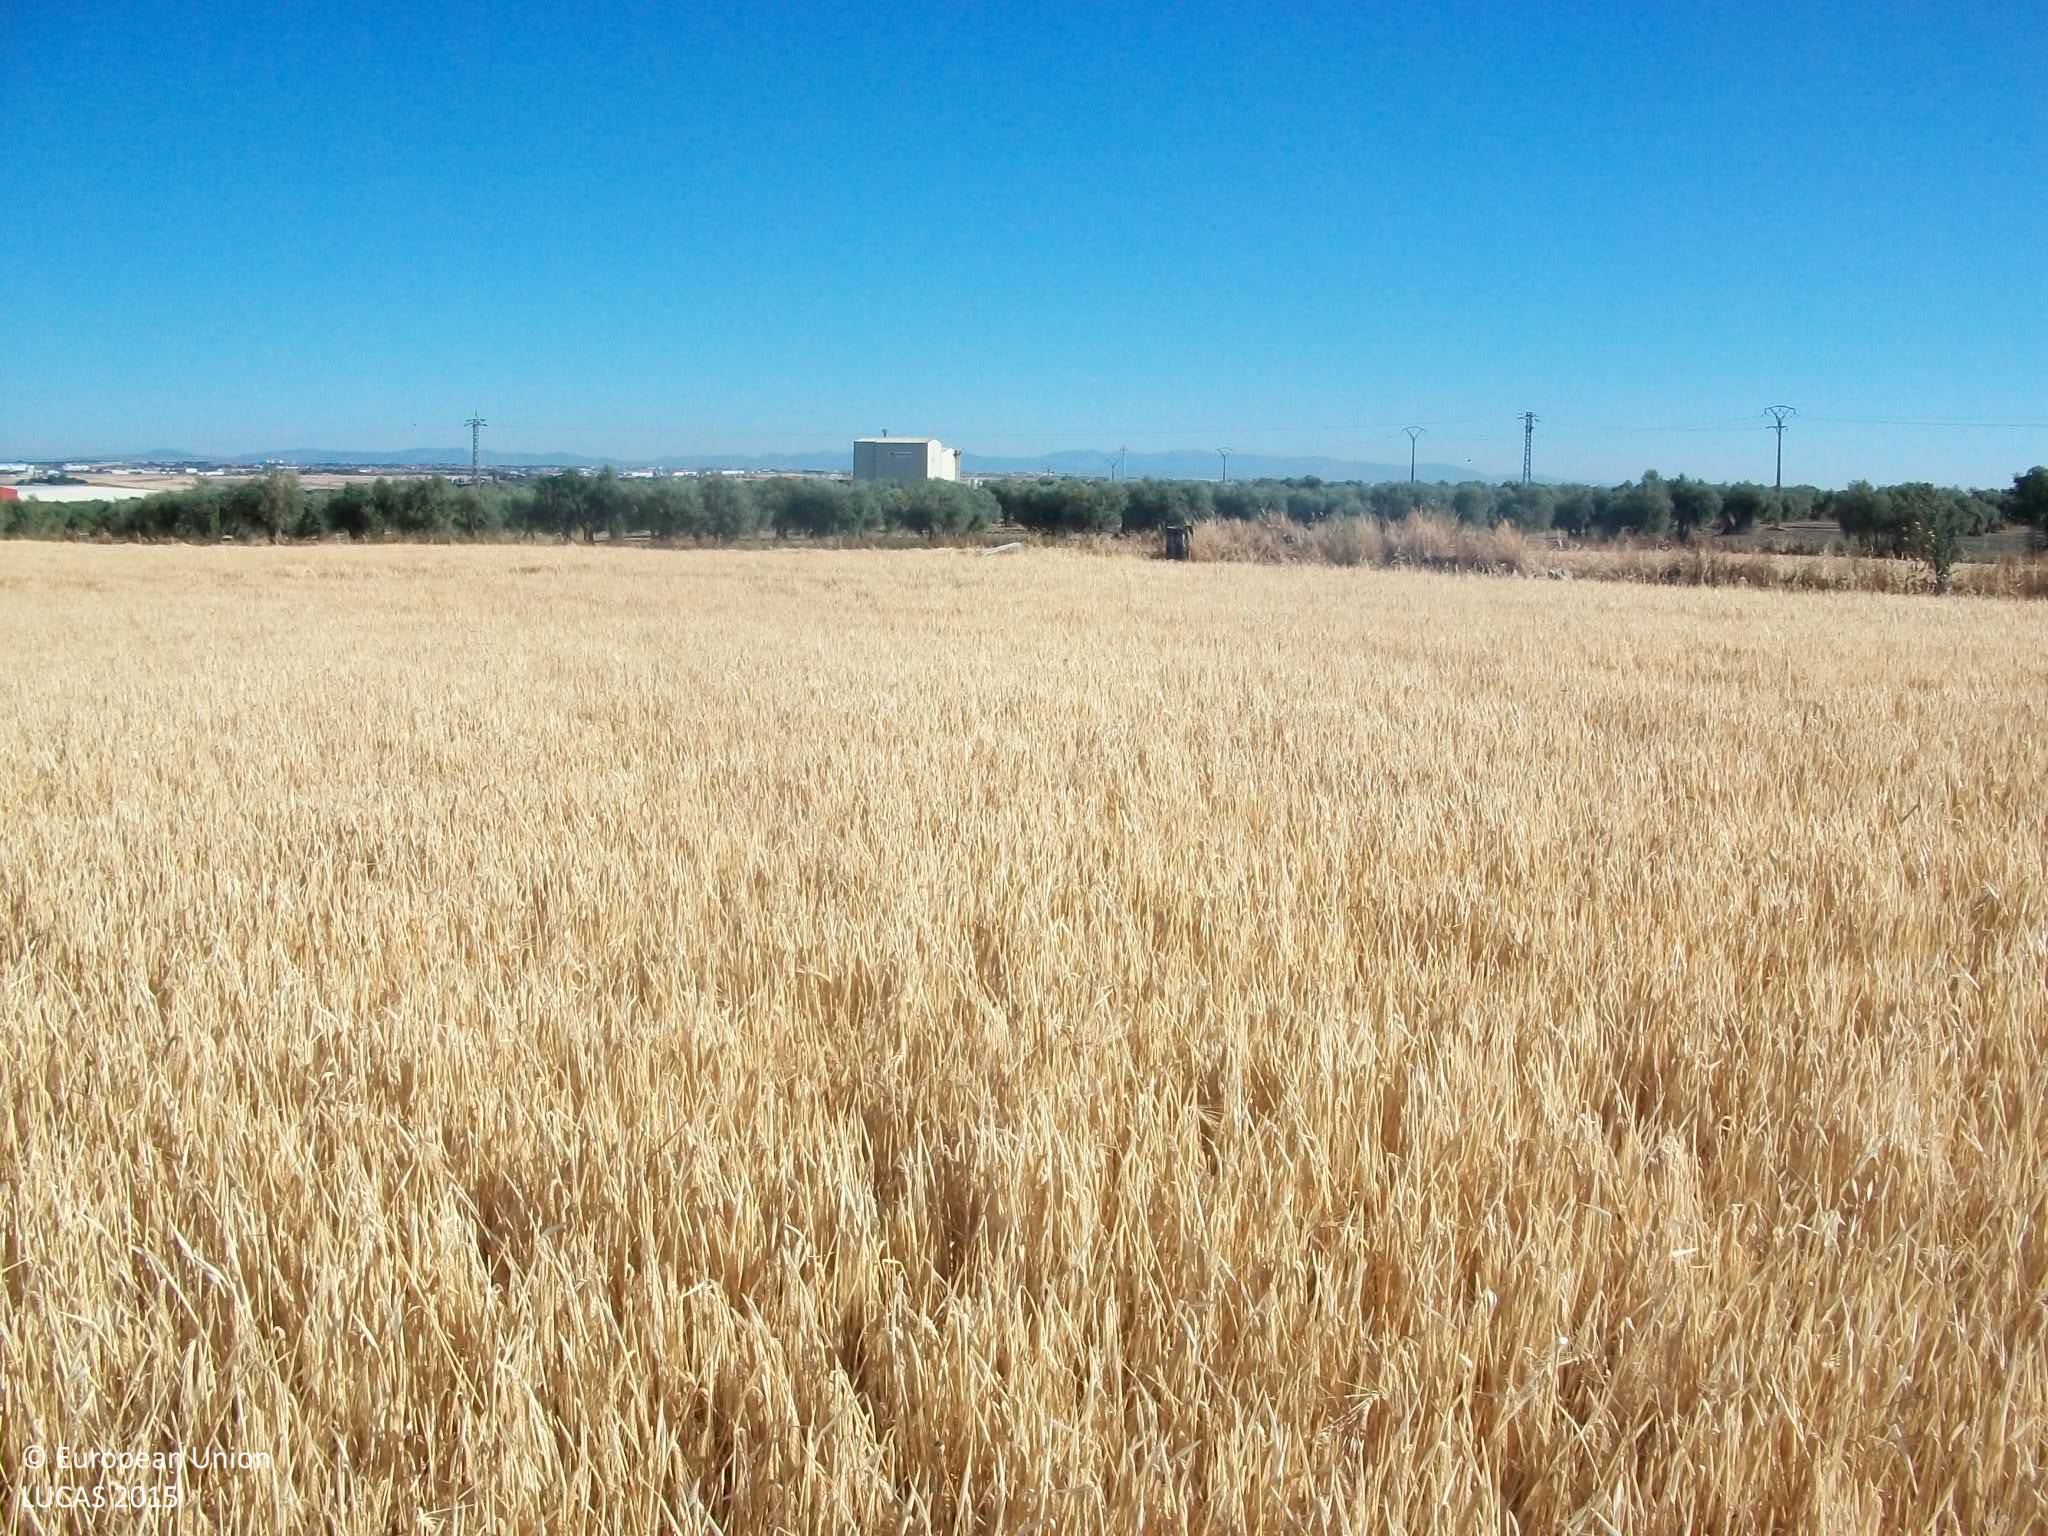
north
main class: Cropland
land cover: Barley
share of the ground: > 75 %
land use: Agriculture (excluding fallow land and kitchen gardens)
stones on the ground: < 10 %
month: June
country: ES
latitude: 40.1153
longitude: -3.7739
